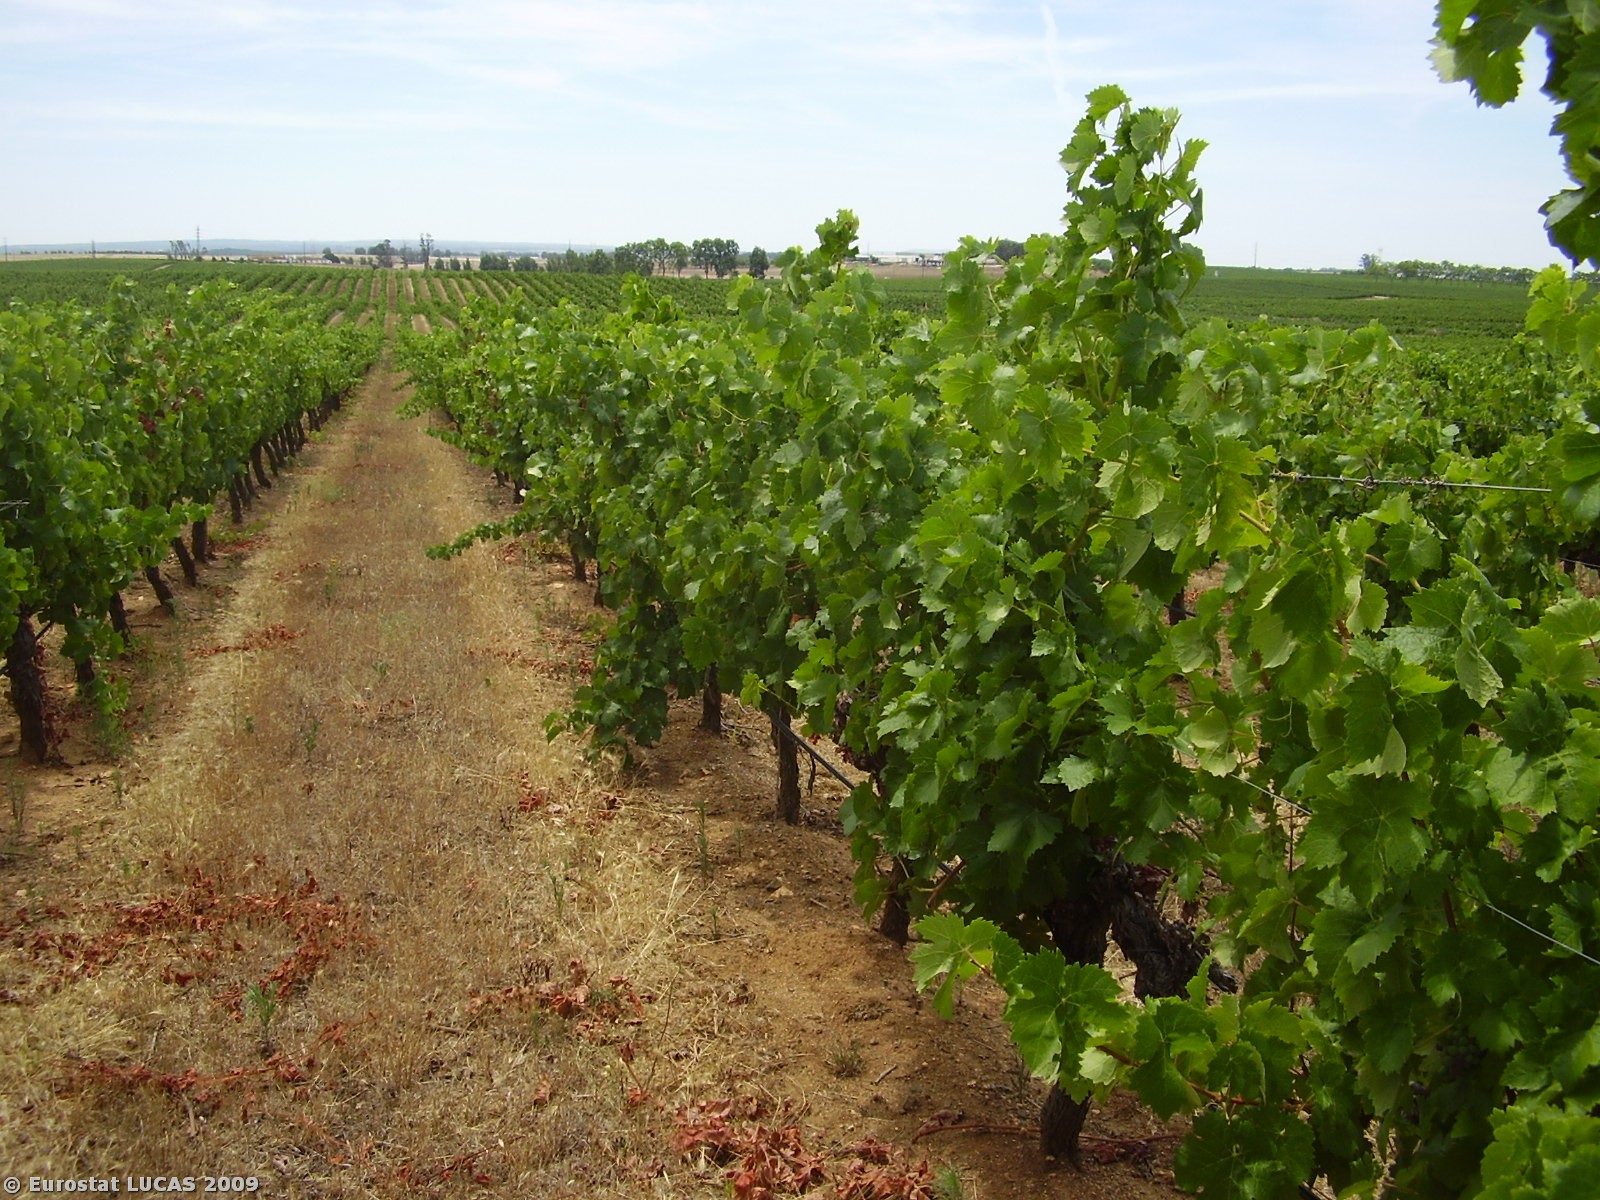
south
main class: Cropland
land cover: Vineyards
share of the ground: 10 - 25 %
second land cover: Spontaneously vegetated surfaces
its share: 50 - 75 %
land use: Agriculture (excluding fallow land and kitchen gardens)
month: July
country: PT
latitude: 38.5581
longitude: -7.8597
